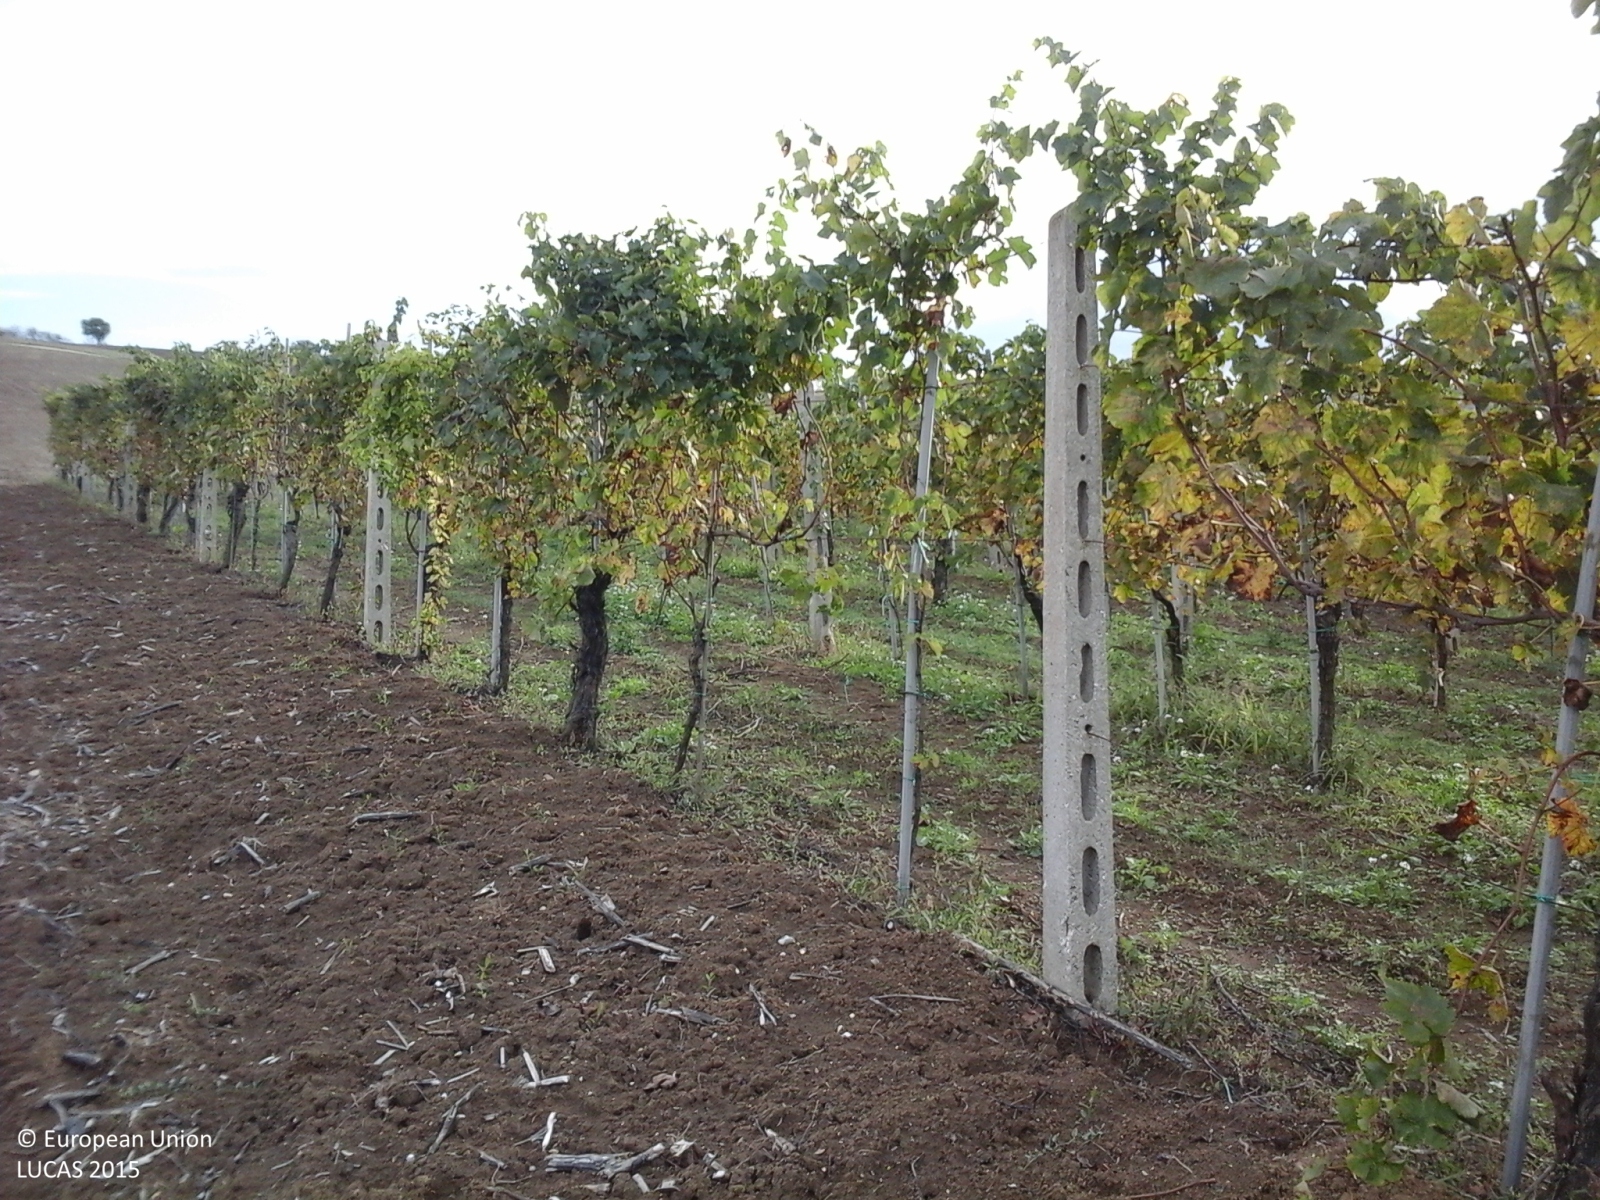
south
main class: Cropland
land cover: Sunflower
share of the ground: < 10 %
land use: Agriculture (excluding fallow land and kitchen gardens)
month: October
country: IT
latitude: 43.5309
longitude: 12.9993
